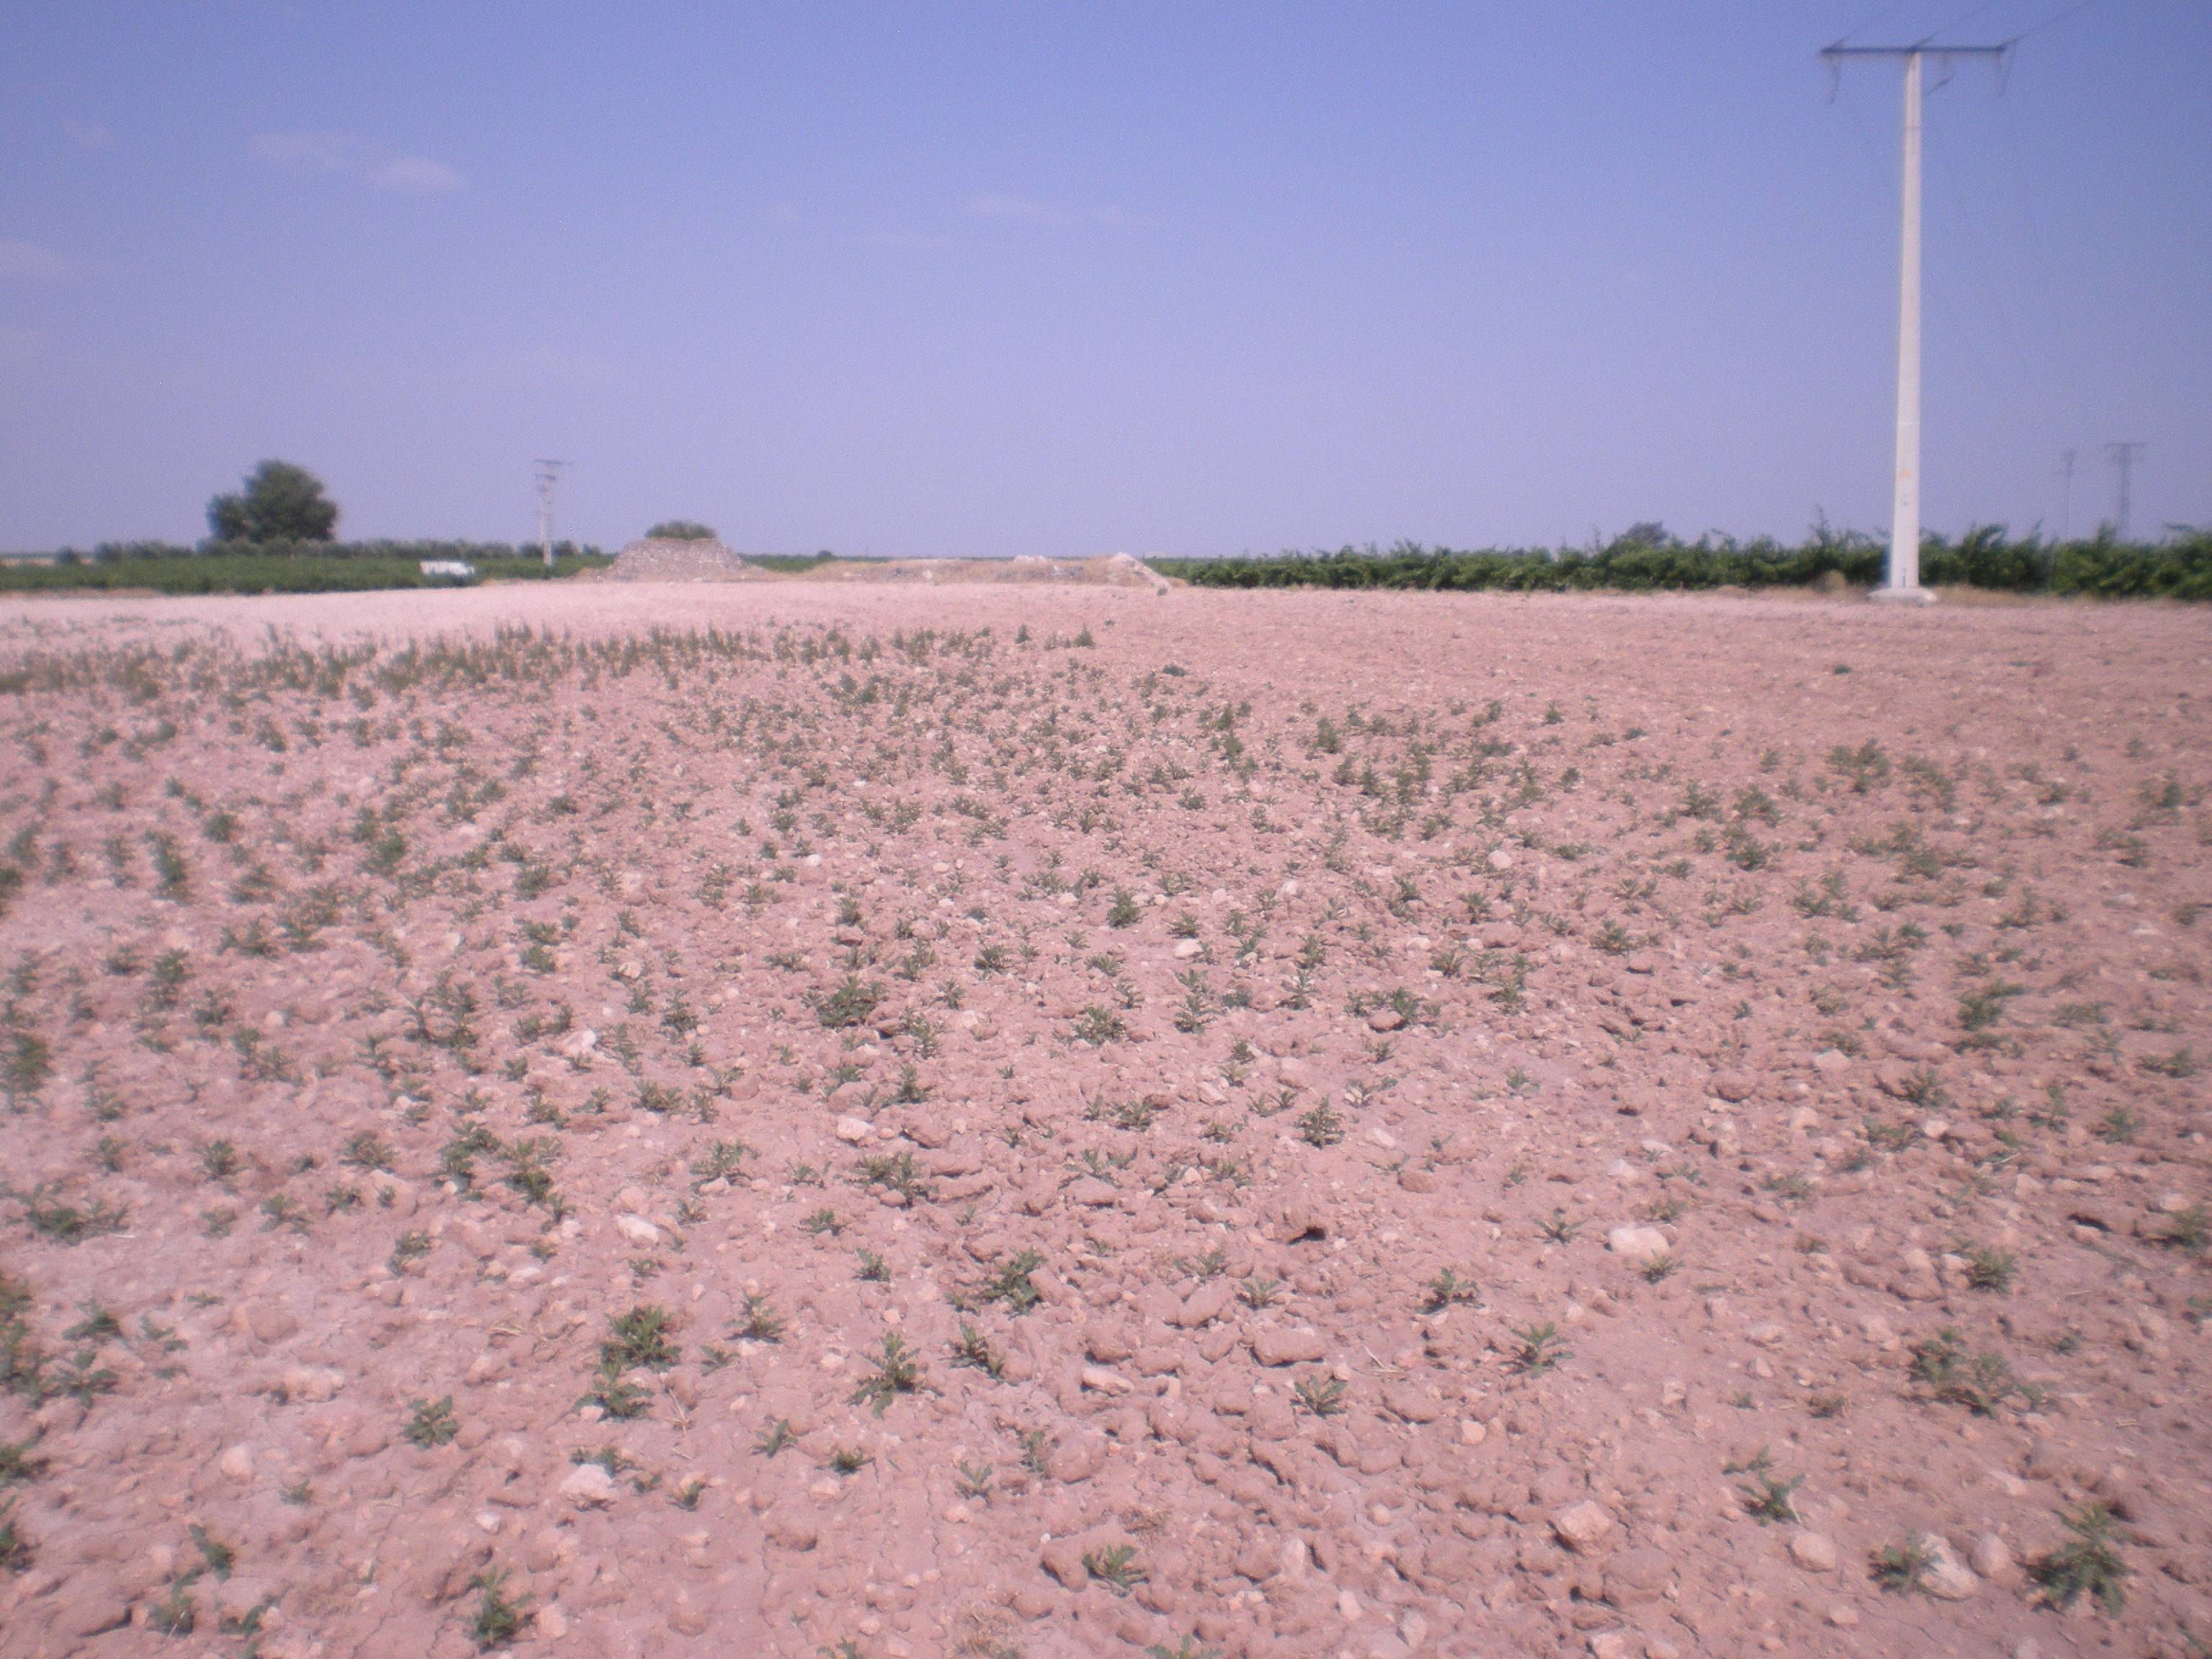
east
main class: Grassland
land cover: Spontaneously vegetated surfaces
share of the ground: 10 - 25 %
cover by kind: unconsolidated bare surface 80 %, herbaceous plants 20 %
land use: Fallow land
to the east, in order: Spontaneously vegetated surfaces; Other bare soil; Dry stone walls; Other bare soil; Tracks; Other bare soil; Grass margins; Tracks; Grass margins; Vineyards; Electric lines; Vineyards
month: June
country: ES
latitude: 39.5555
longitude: -3.3239
